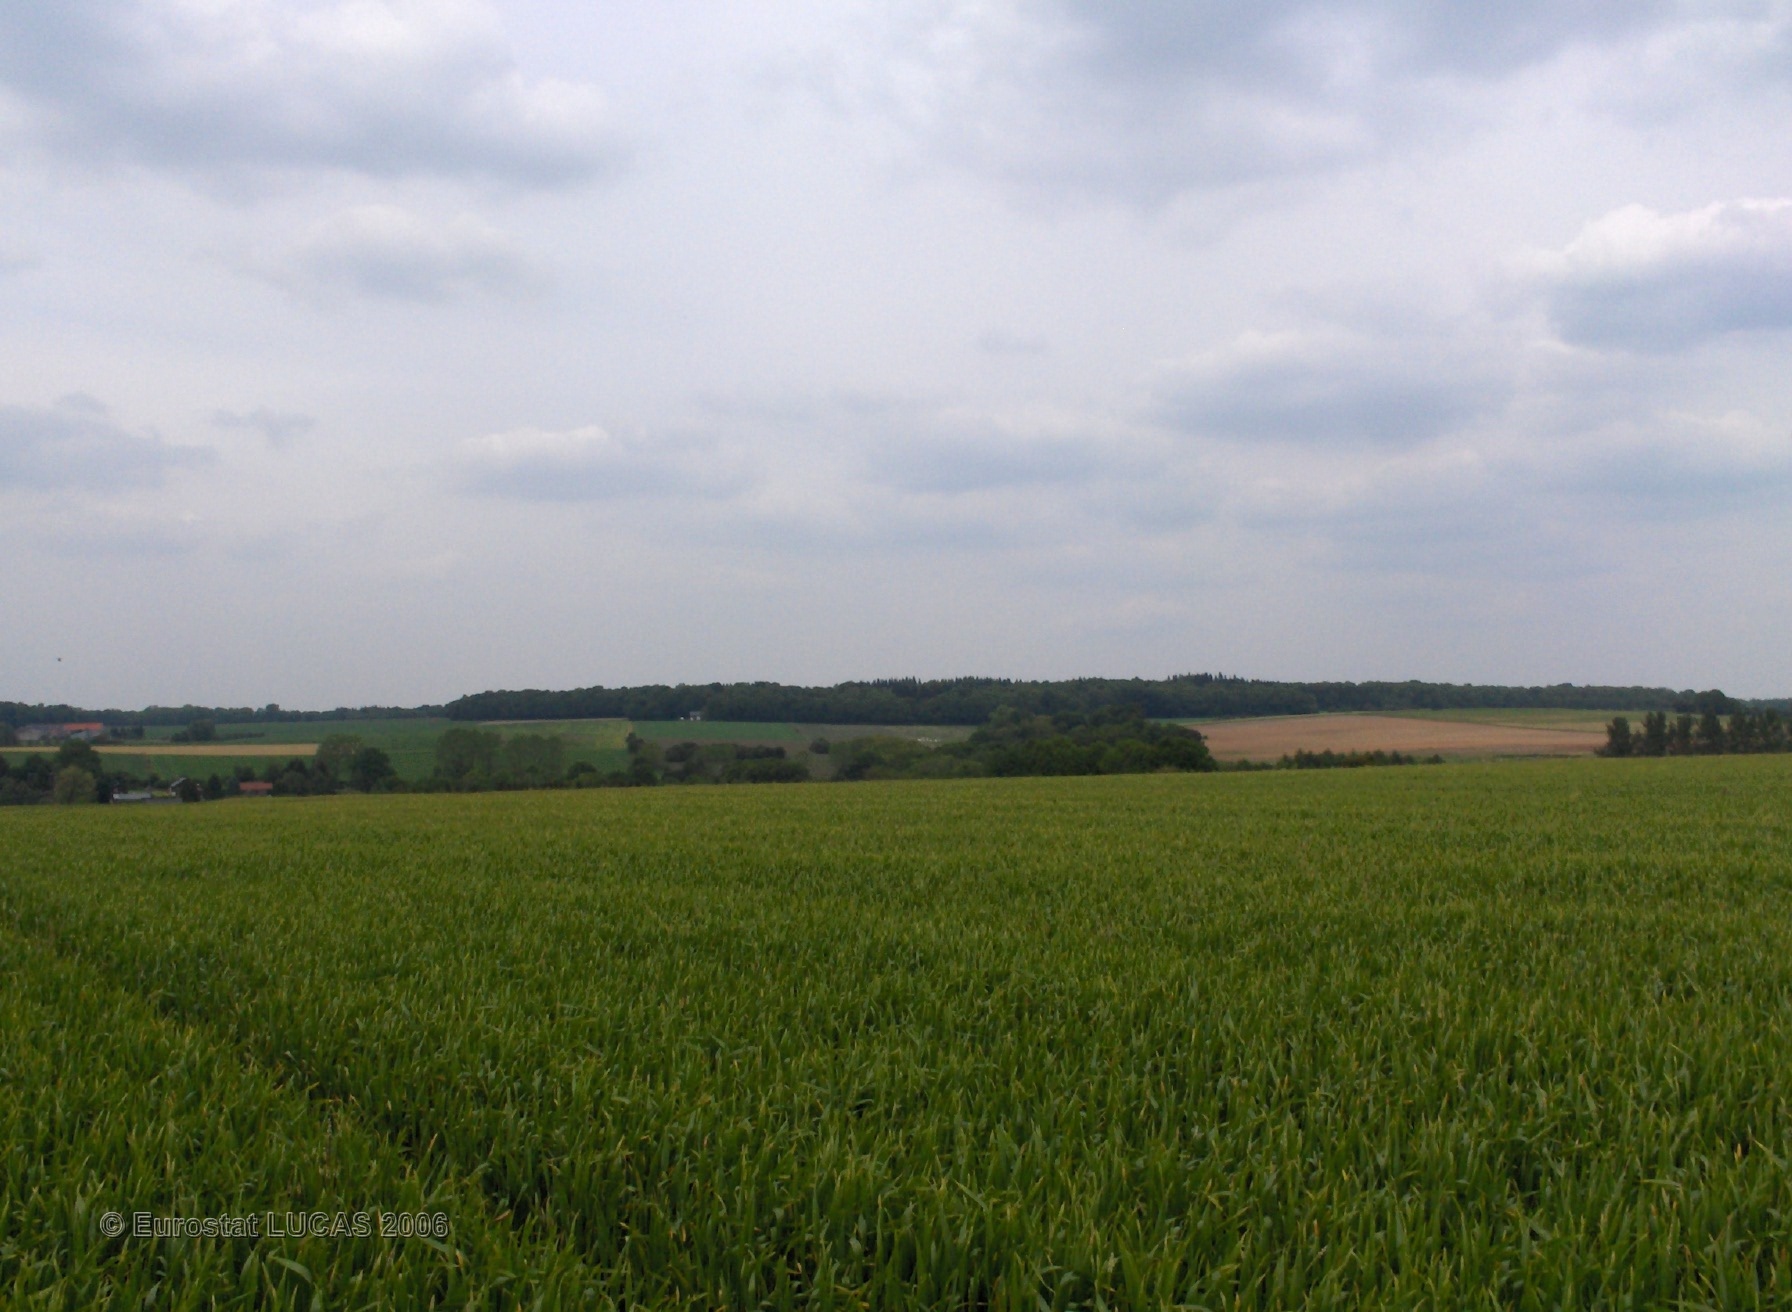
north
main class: Cropland
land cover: Common wheat
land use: Agriculture (excluding fallow land and kitchen gardens)
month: June
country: BE
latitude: 50.2338
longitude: 4.5425
